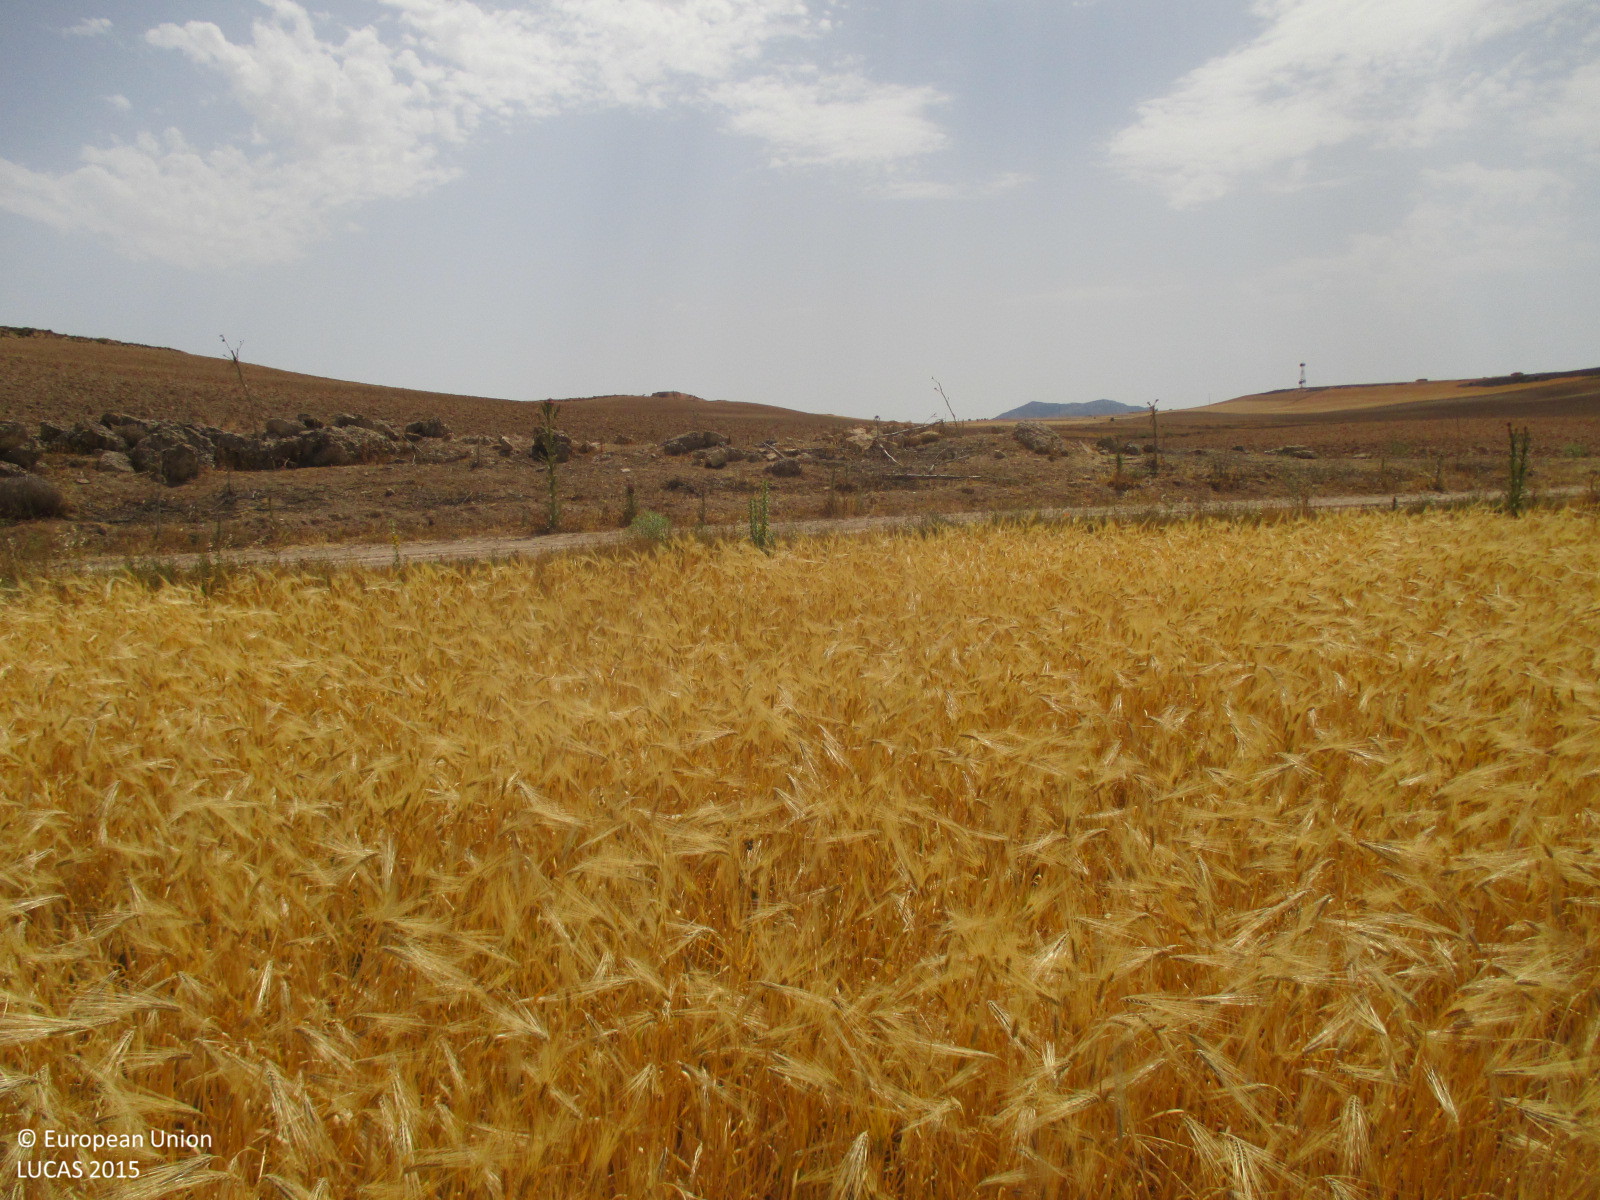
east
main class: Cropland
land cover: Barley
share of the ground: > 75 %
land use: Agriculture (excluding fallow land and kitchen gardens)
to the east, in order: Barley; Grass margins; Tracks; Grass margins; Dry stone walls; Other bare soil
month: July
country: ES
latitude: 37.7932
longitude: -2.2637
